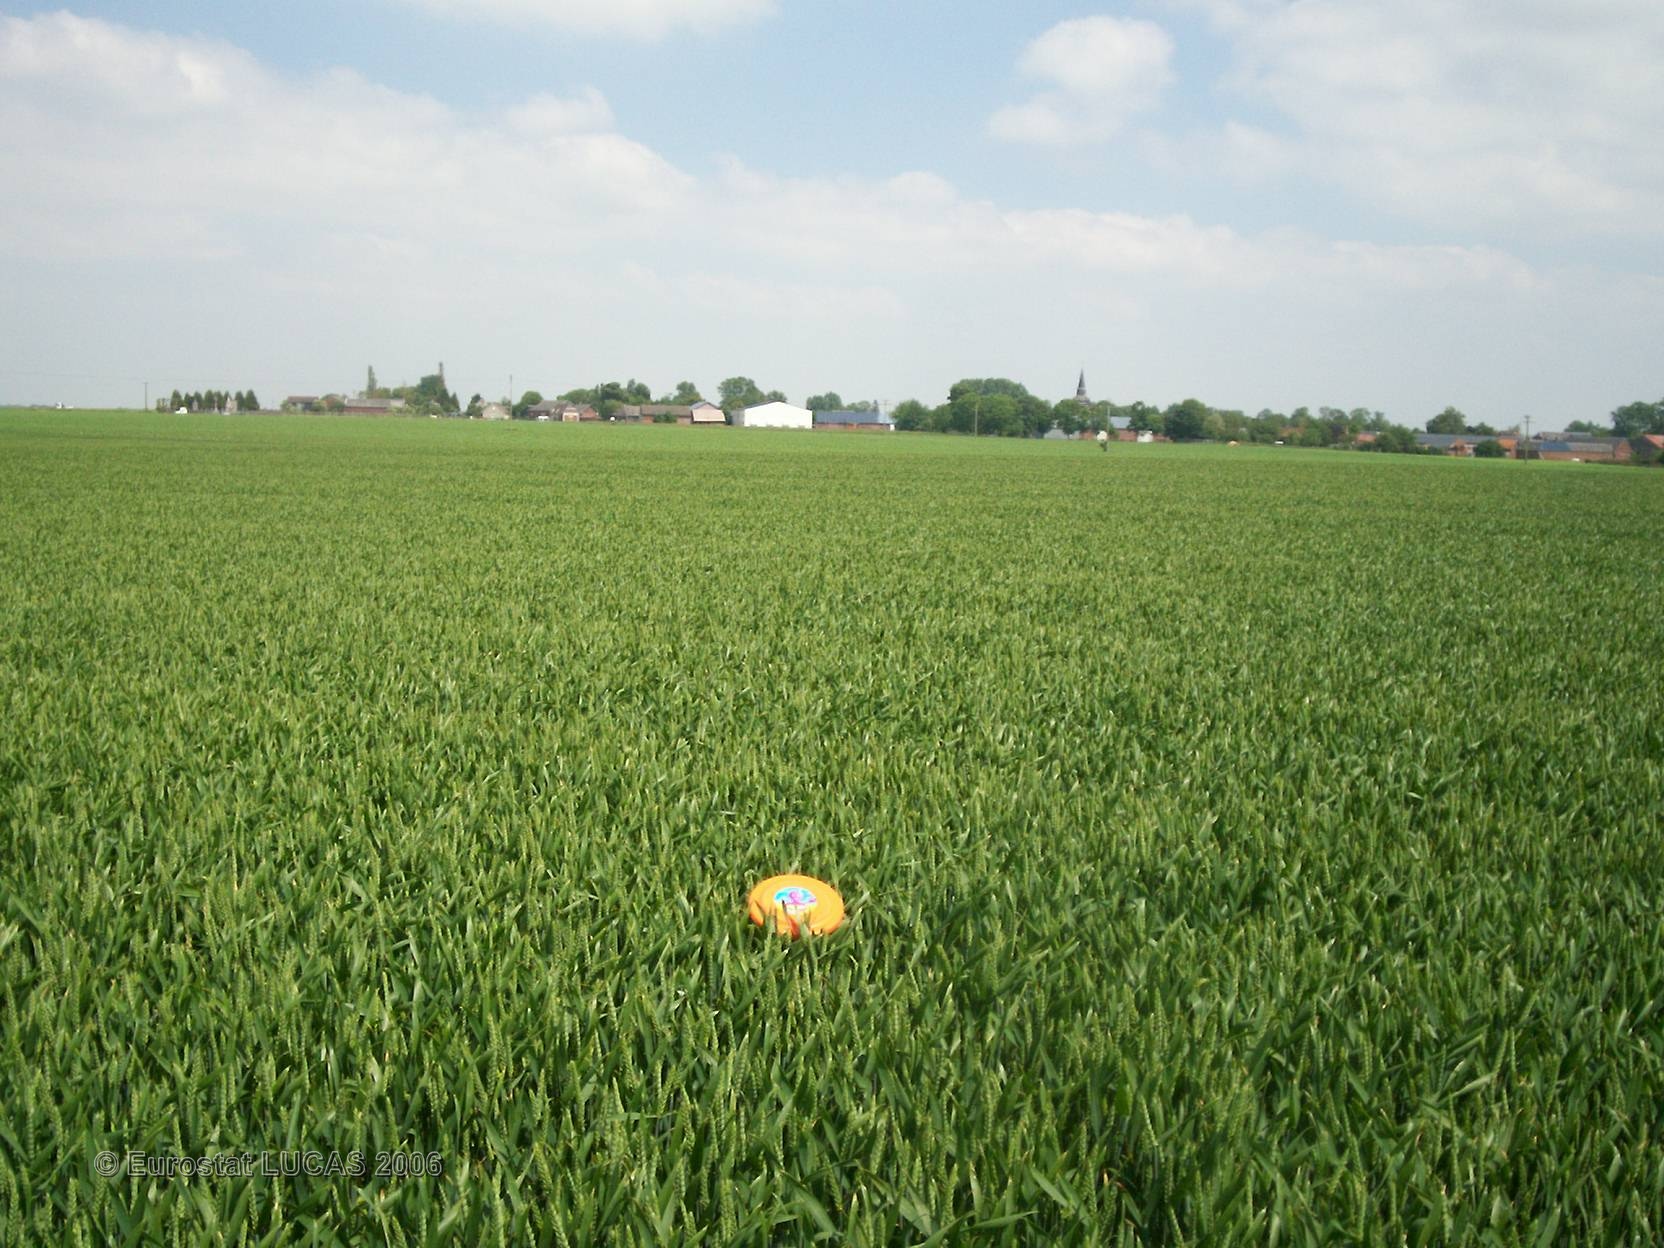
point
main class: Cropland
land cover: Common wheat
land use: Agriculture (excluding fallow land and kitchen gardens)
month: June
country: FR
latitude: 49.7695
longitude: 2.6994
